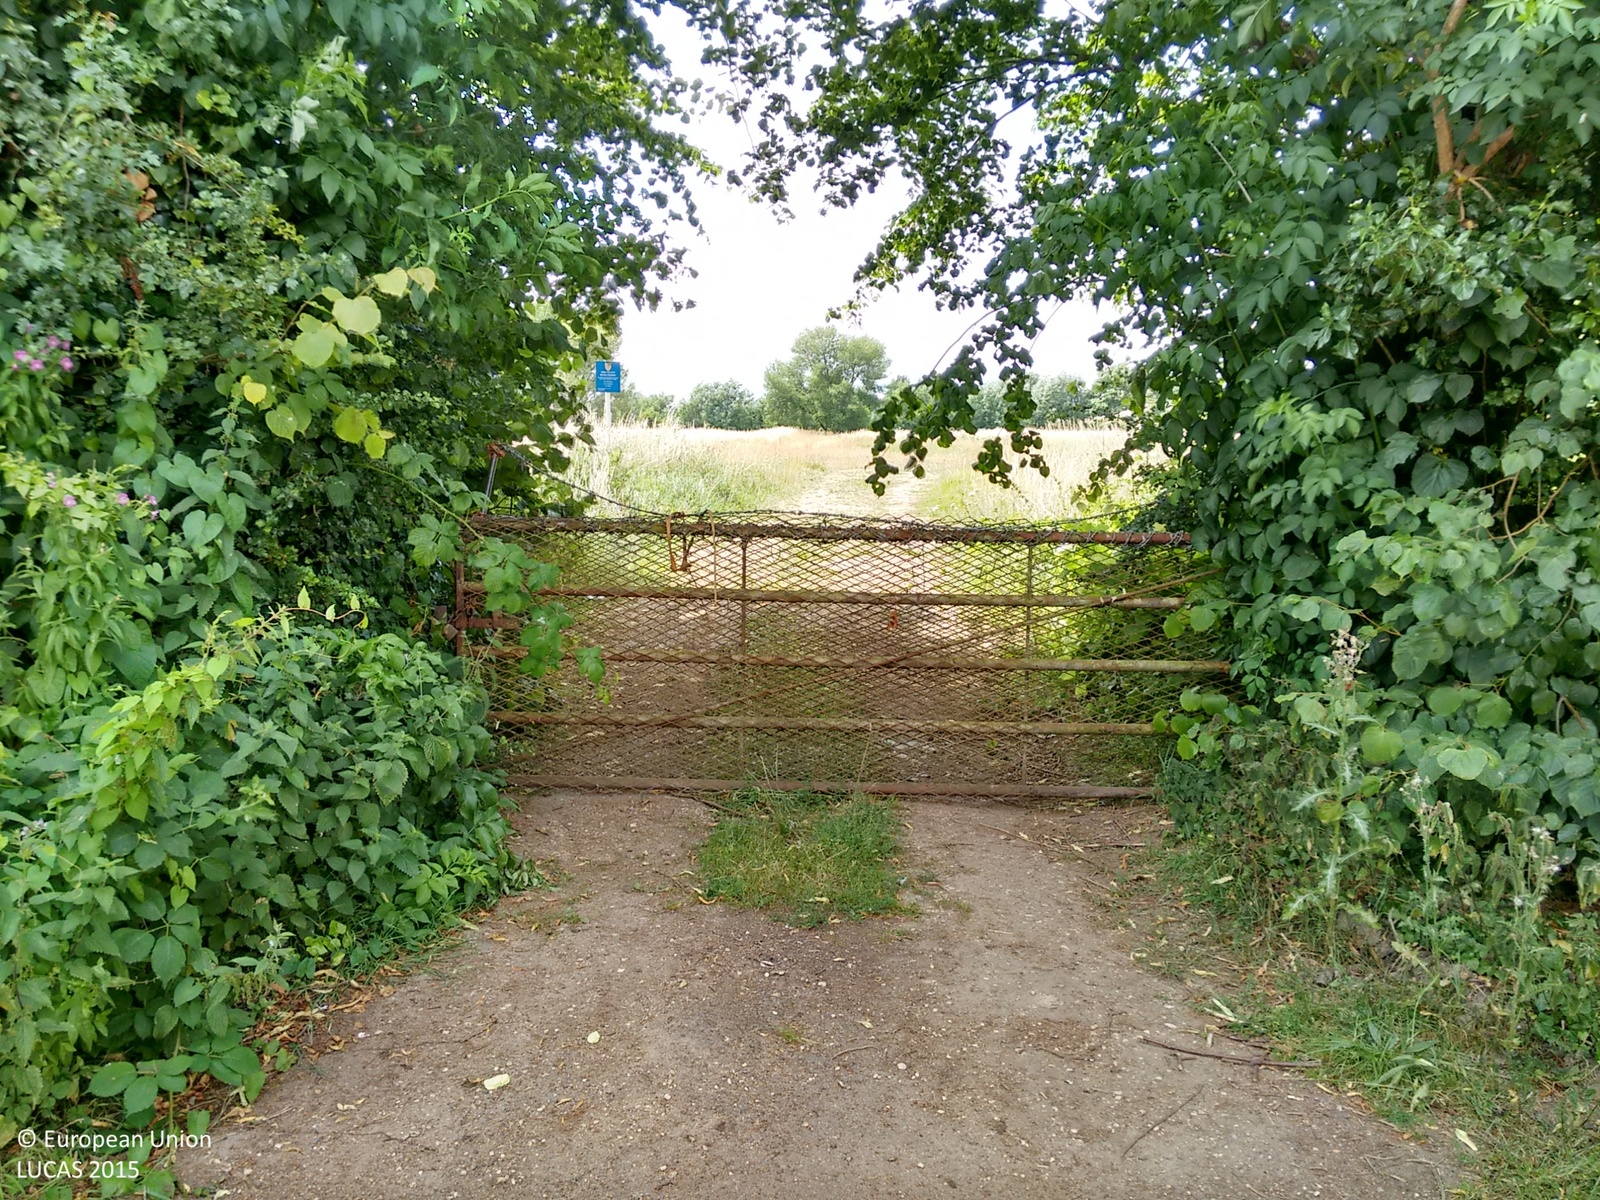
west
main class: Grassland
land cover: Grassland with sparse tree/shrub cover
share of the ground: > 75 %
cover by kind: herbaceous plants 95 %, broadleaved forest trees 5 %
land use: Agriculture (excluding fallow land and kitchen gardens)
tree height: > 5 m
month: July
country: GB
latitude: 51.7328
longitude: -1.2403
